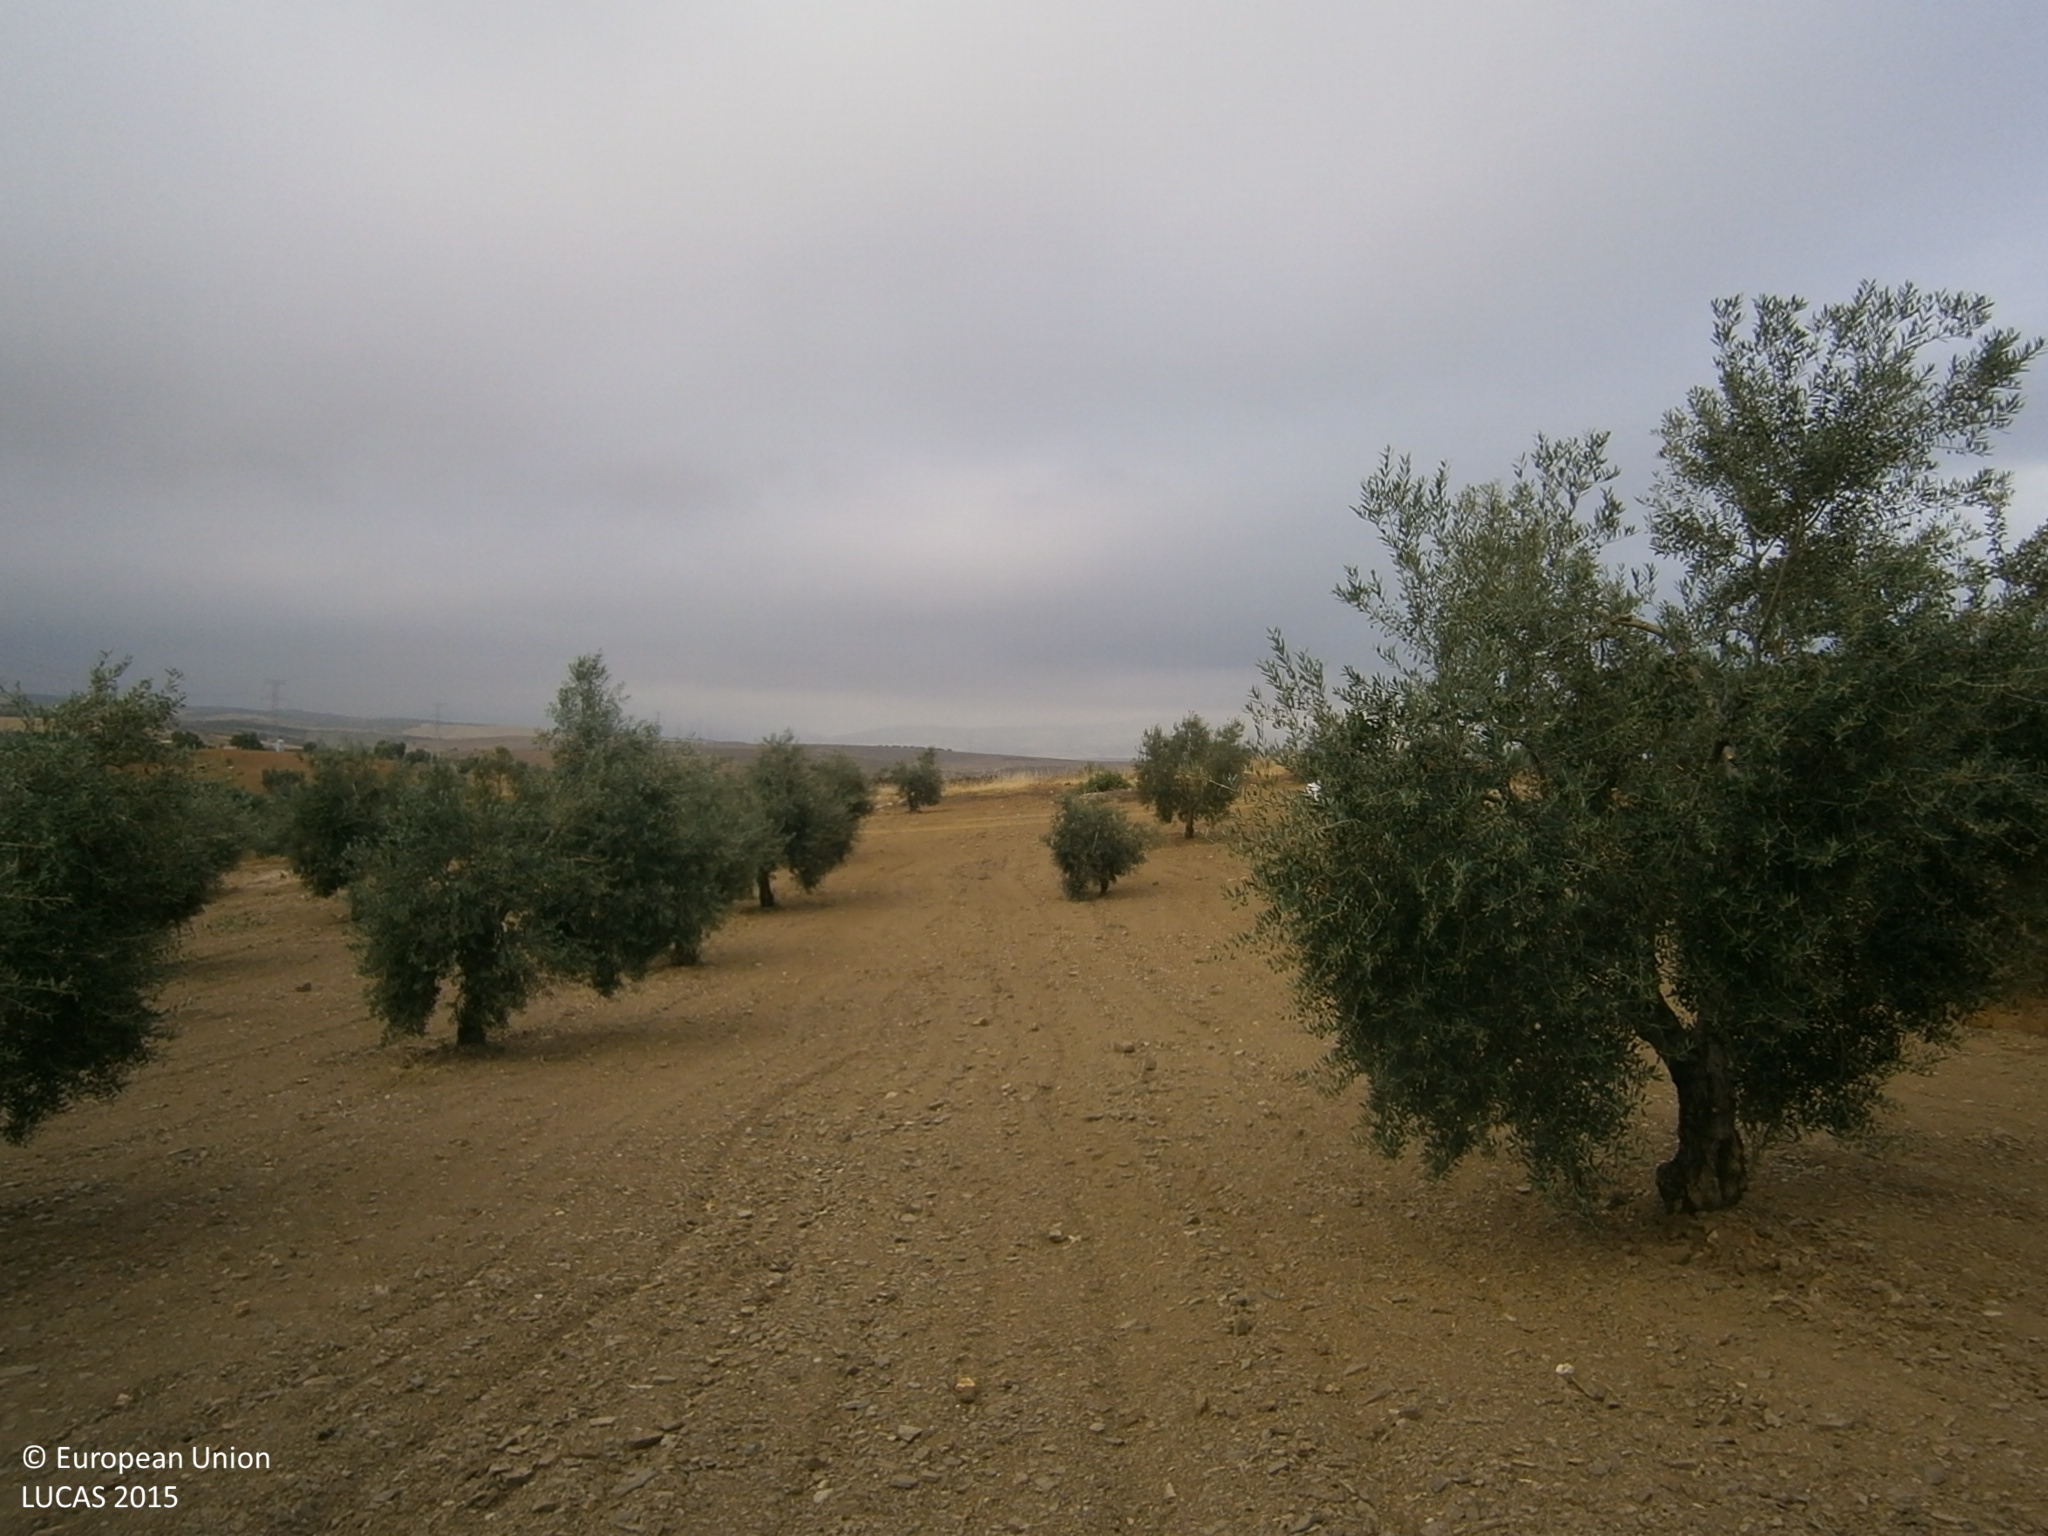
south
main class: Cropland
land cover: Olive groves
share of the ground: 10 - 25 %
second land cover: Other bare soil
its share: > 75 %
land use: Agriculture (excluding fallow land and kitchen gardens)
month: June
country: ES
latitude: 38.5899
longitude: -6.4600
